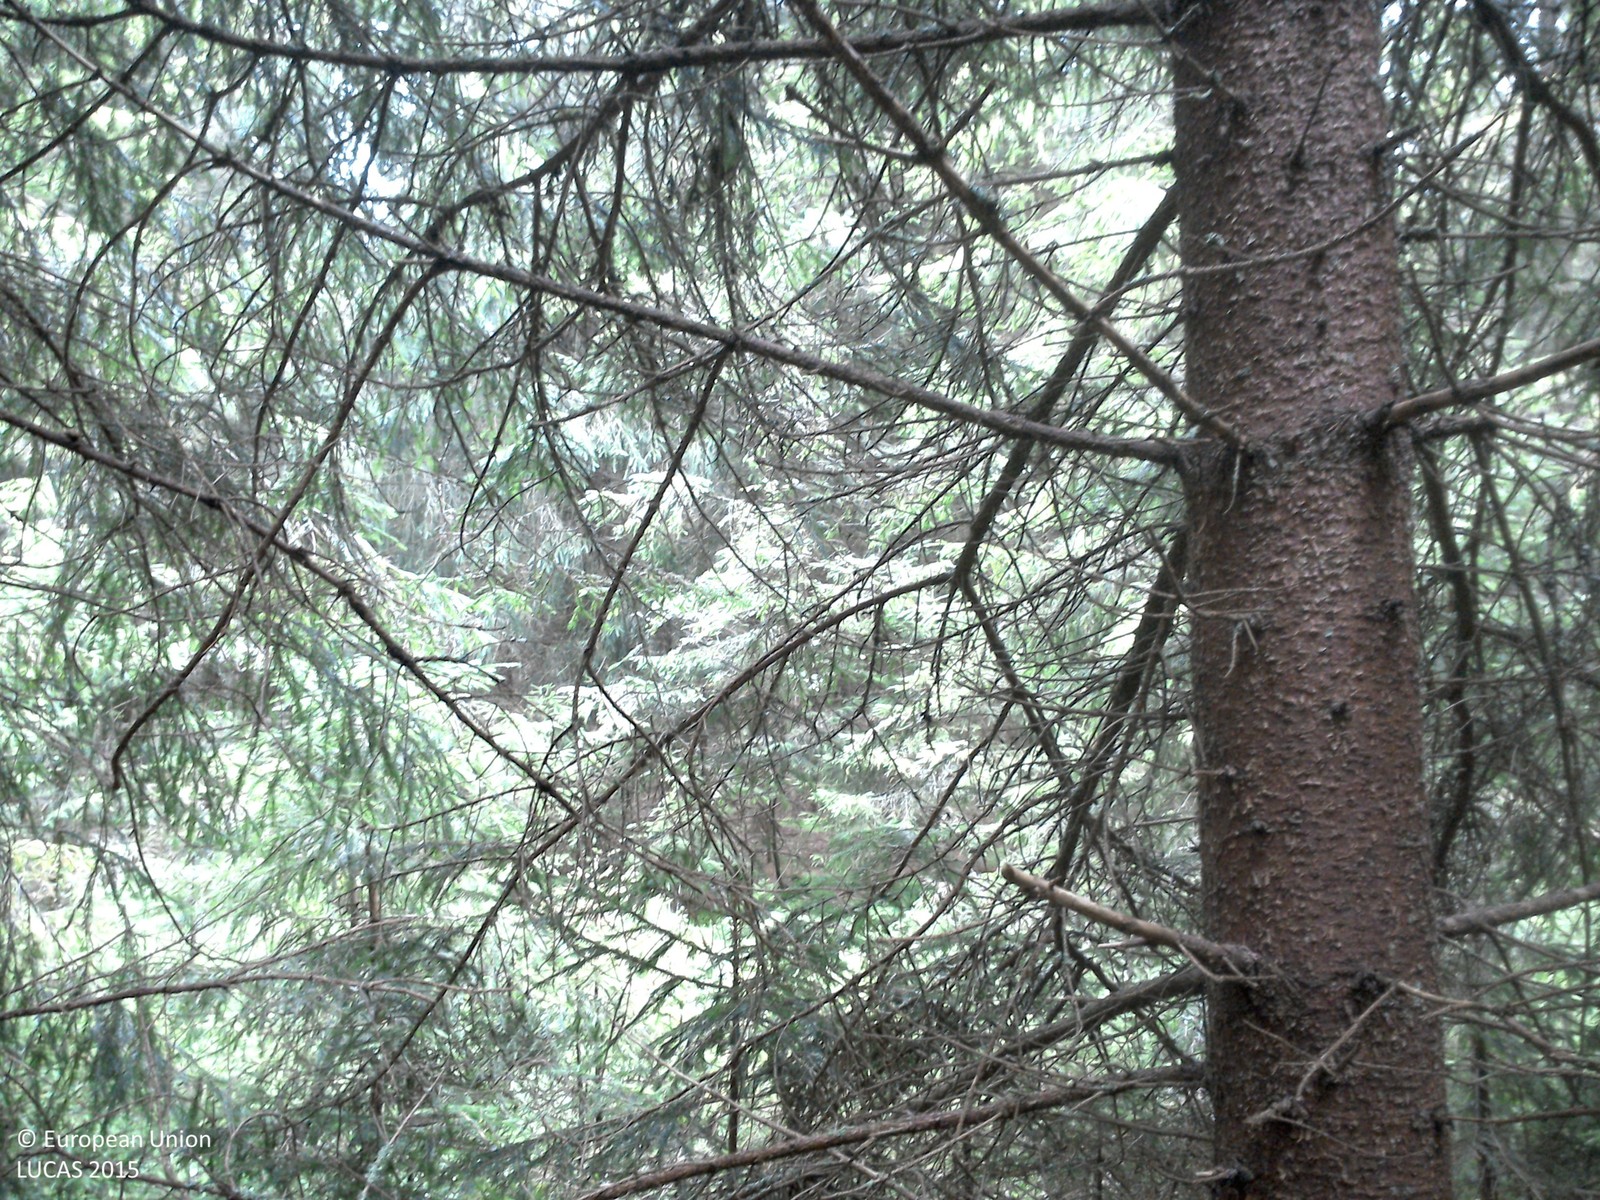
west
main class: Woodland
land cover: Spruce dominated coniferous woodland
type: boreal forest
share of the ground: > 75 %
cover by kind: coniferous forest trees 90 %, lichens and mosses 10 %
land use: Forestry
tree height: > 5 m
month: August
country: SE
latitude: 57.8445
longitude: 15.3022
